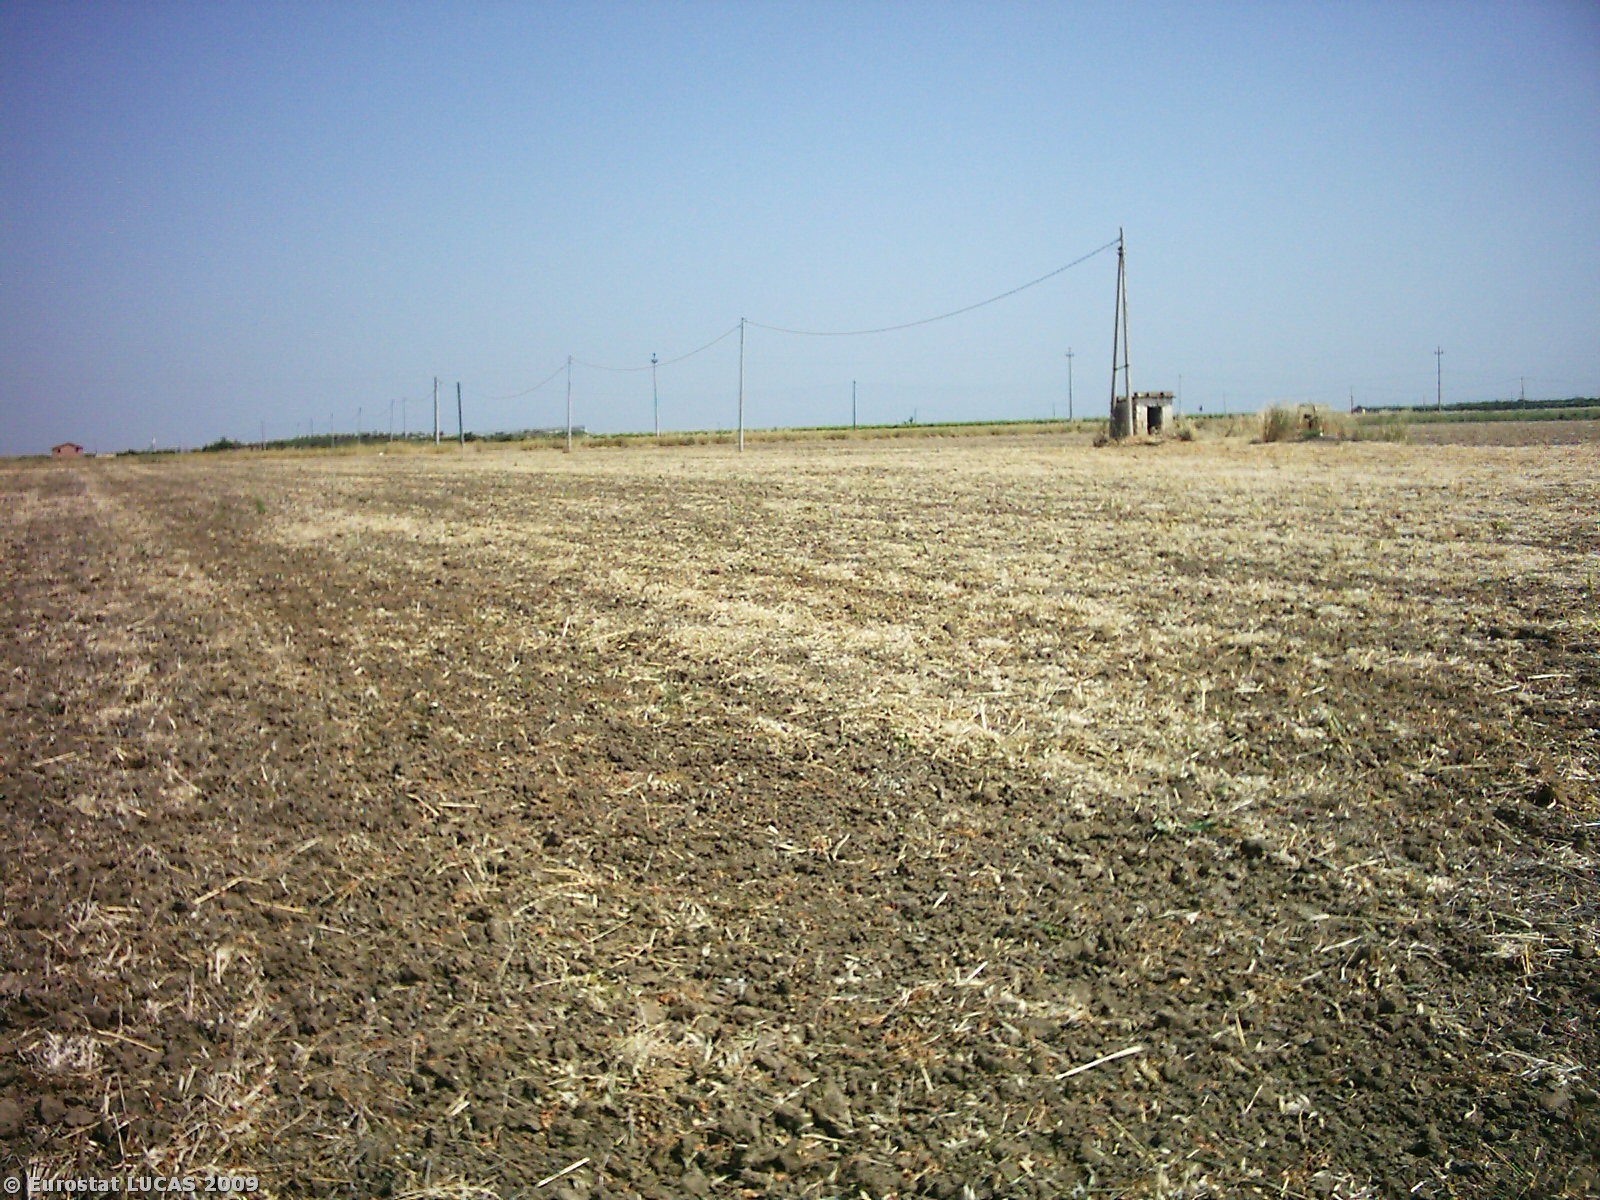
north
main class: Cropland
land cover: Temporary grasslands
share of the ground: < 10 %
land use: Agriculture (excluding fallow land and kitchen gardens)
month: May
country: IT
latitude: 41.3369
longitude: 15.6572
